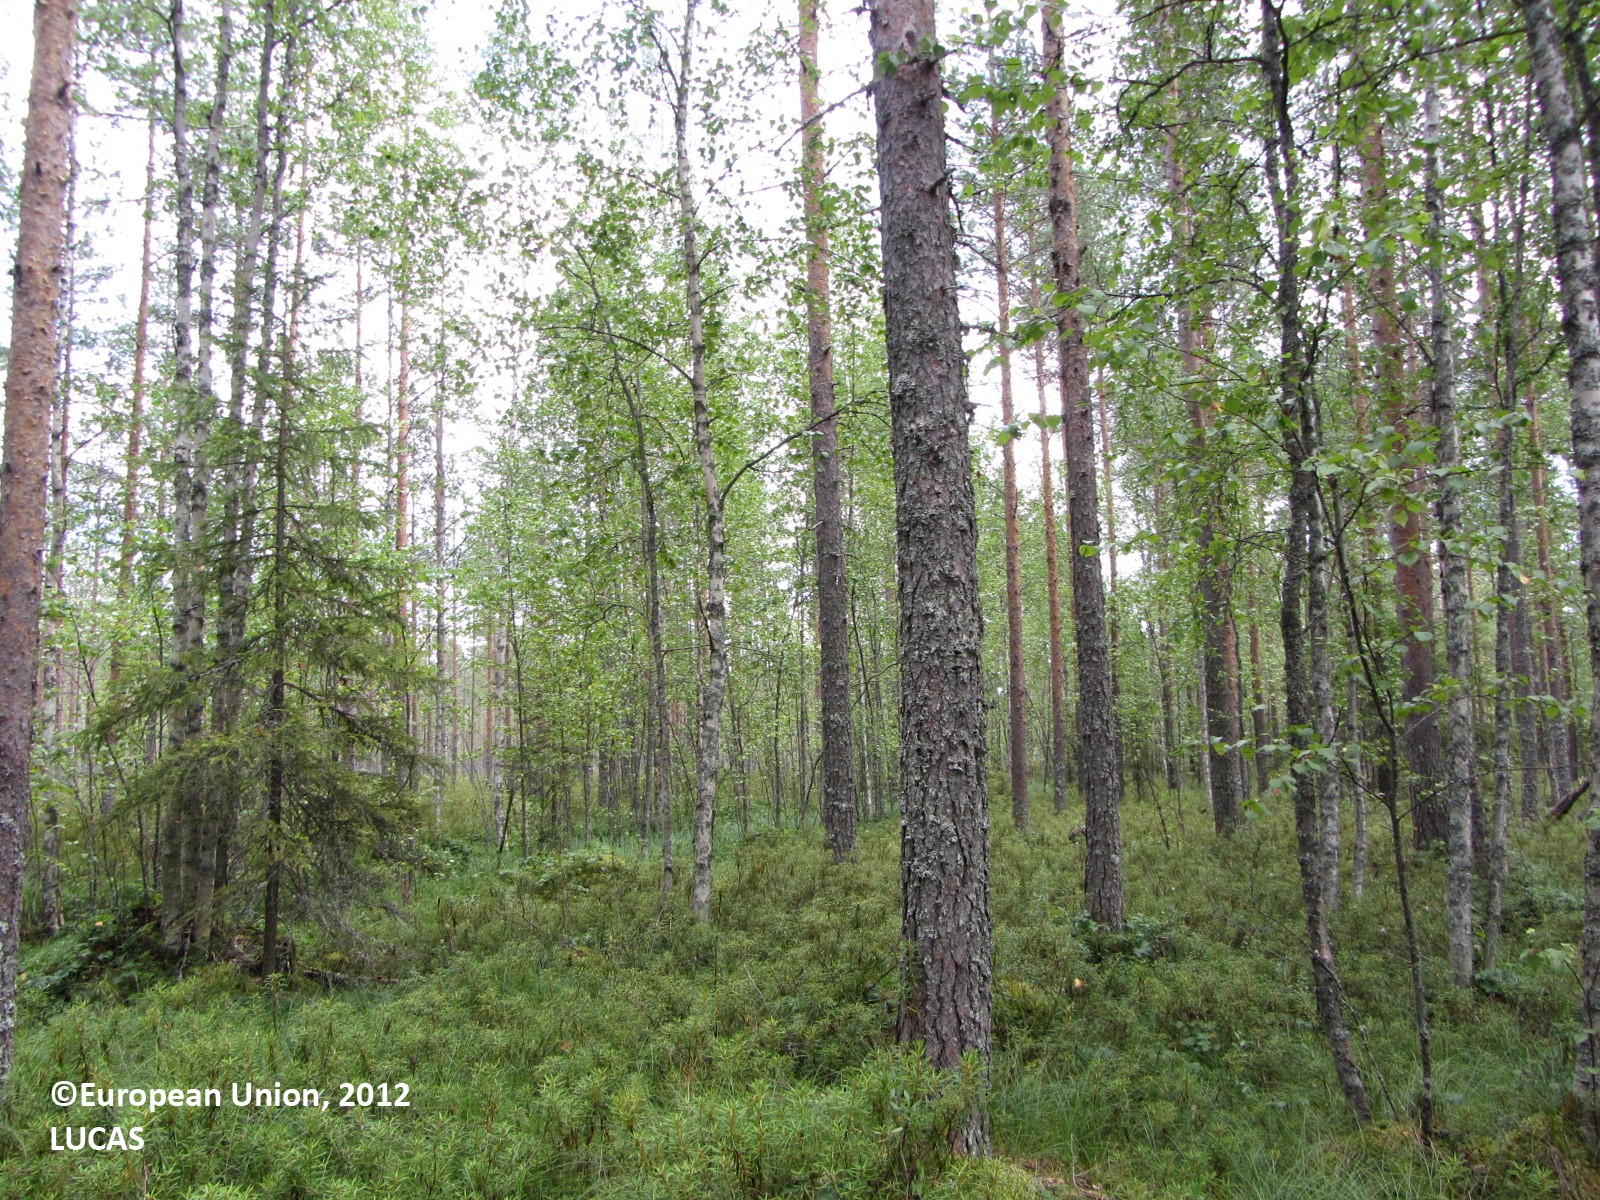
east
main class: Woodland
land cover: Pine dominated mixed woodland
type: mire and swamp forests
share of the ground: > 75 %
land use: Forestry
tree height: > 5 m
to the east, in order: Pine dominated mixed woodland; Ditches and canals; Pine dominated coniferous woodland; Ditches and canals; Pine dominated coniferous woodland; Tracks; Pine dominated coniferous woodland; Ditches and canals; Pine dominated mixed woodland
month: August
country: FI
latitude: 63.3225
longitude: 25.2503
